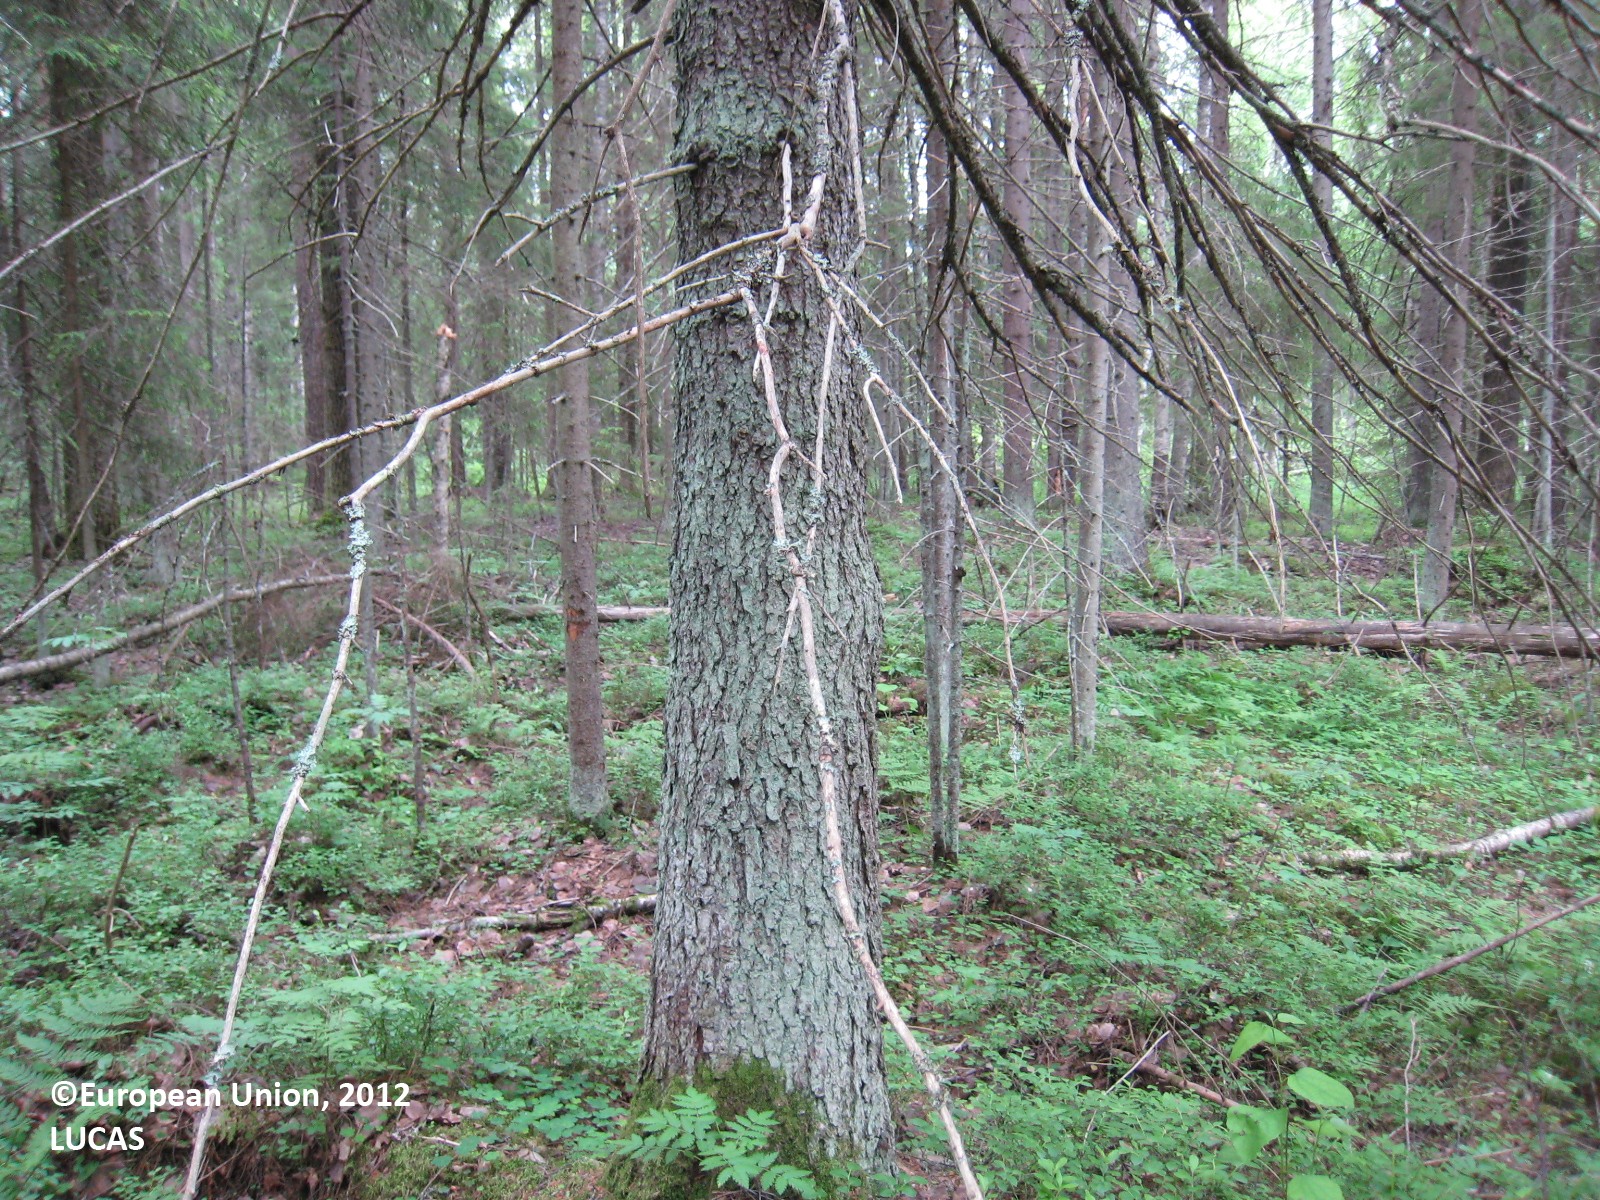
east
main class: Woodland
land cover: Spruce dominated coniferous woodland
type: boreal forest
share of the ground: 50 - 75 %
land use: Forestry
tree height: > 5 m
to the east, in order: Spruce dominated coniferous woodland; Spruce dominated mixed woodland; Grassland without tree/shrub cover; Paved roads, cycling and walking lanes; Shruby margins; Ditches and canals; Abandoned hedges; Spontaneously vegetated surfaces; Other mixed woodland; Spontaneously vegetated surfaces; Spruce dominated mixed woodland; Dry stone walls; Spruce dominated mixed woodland; Rivers and streams; Other mixed woodland; Spruce dominated mixed woodland
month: June
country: FI
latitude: 62.0653
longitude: 26.3055
